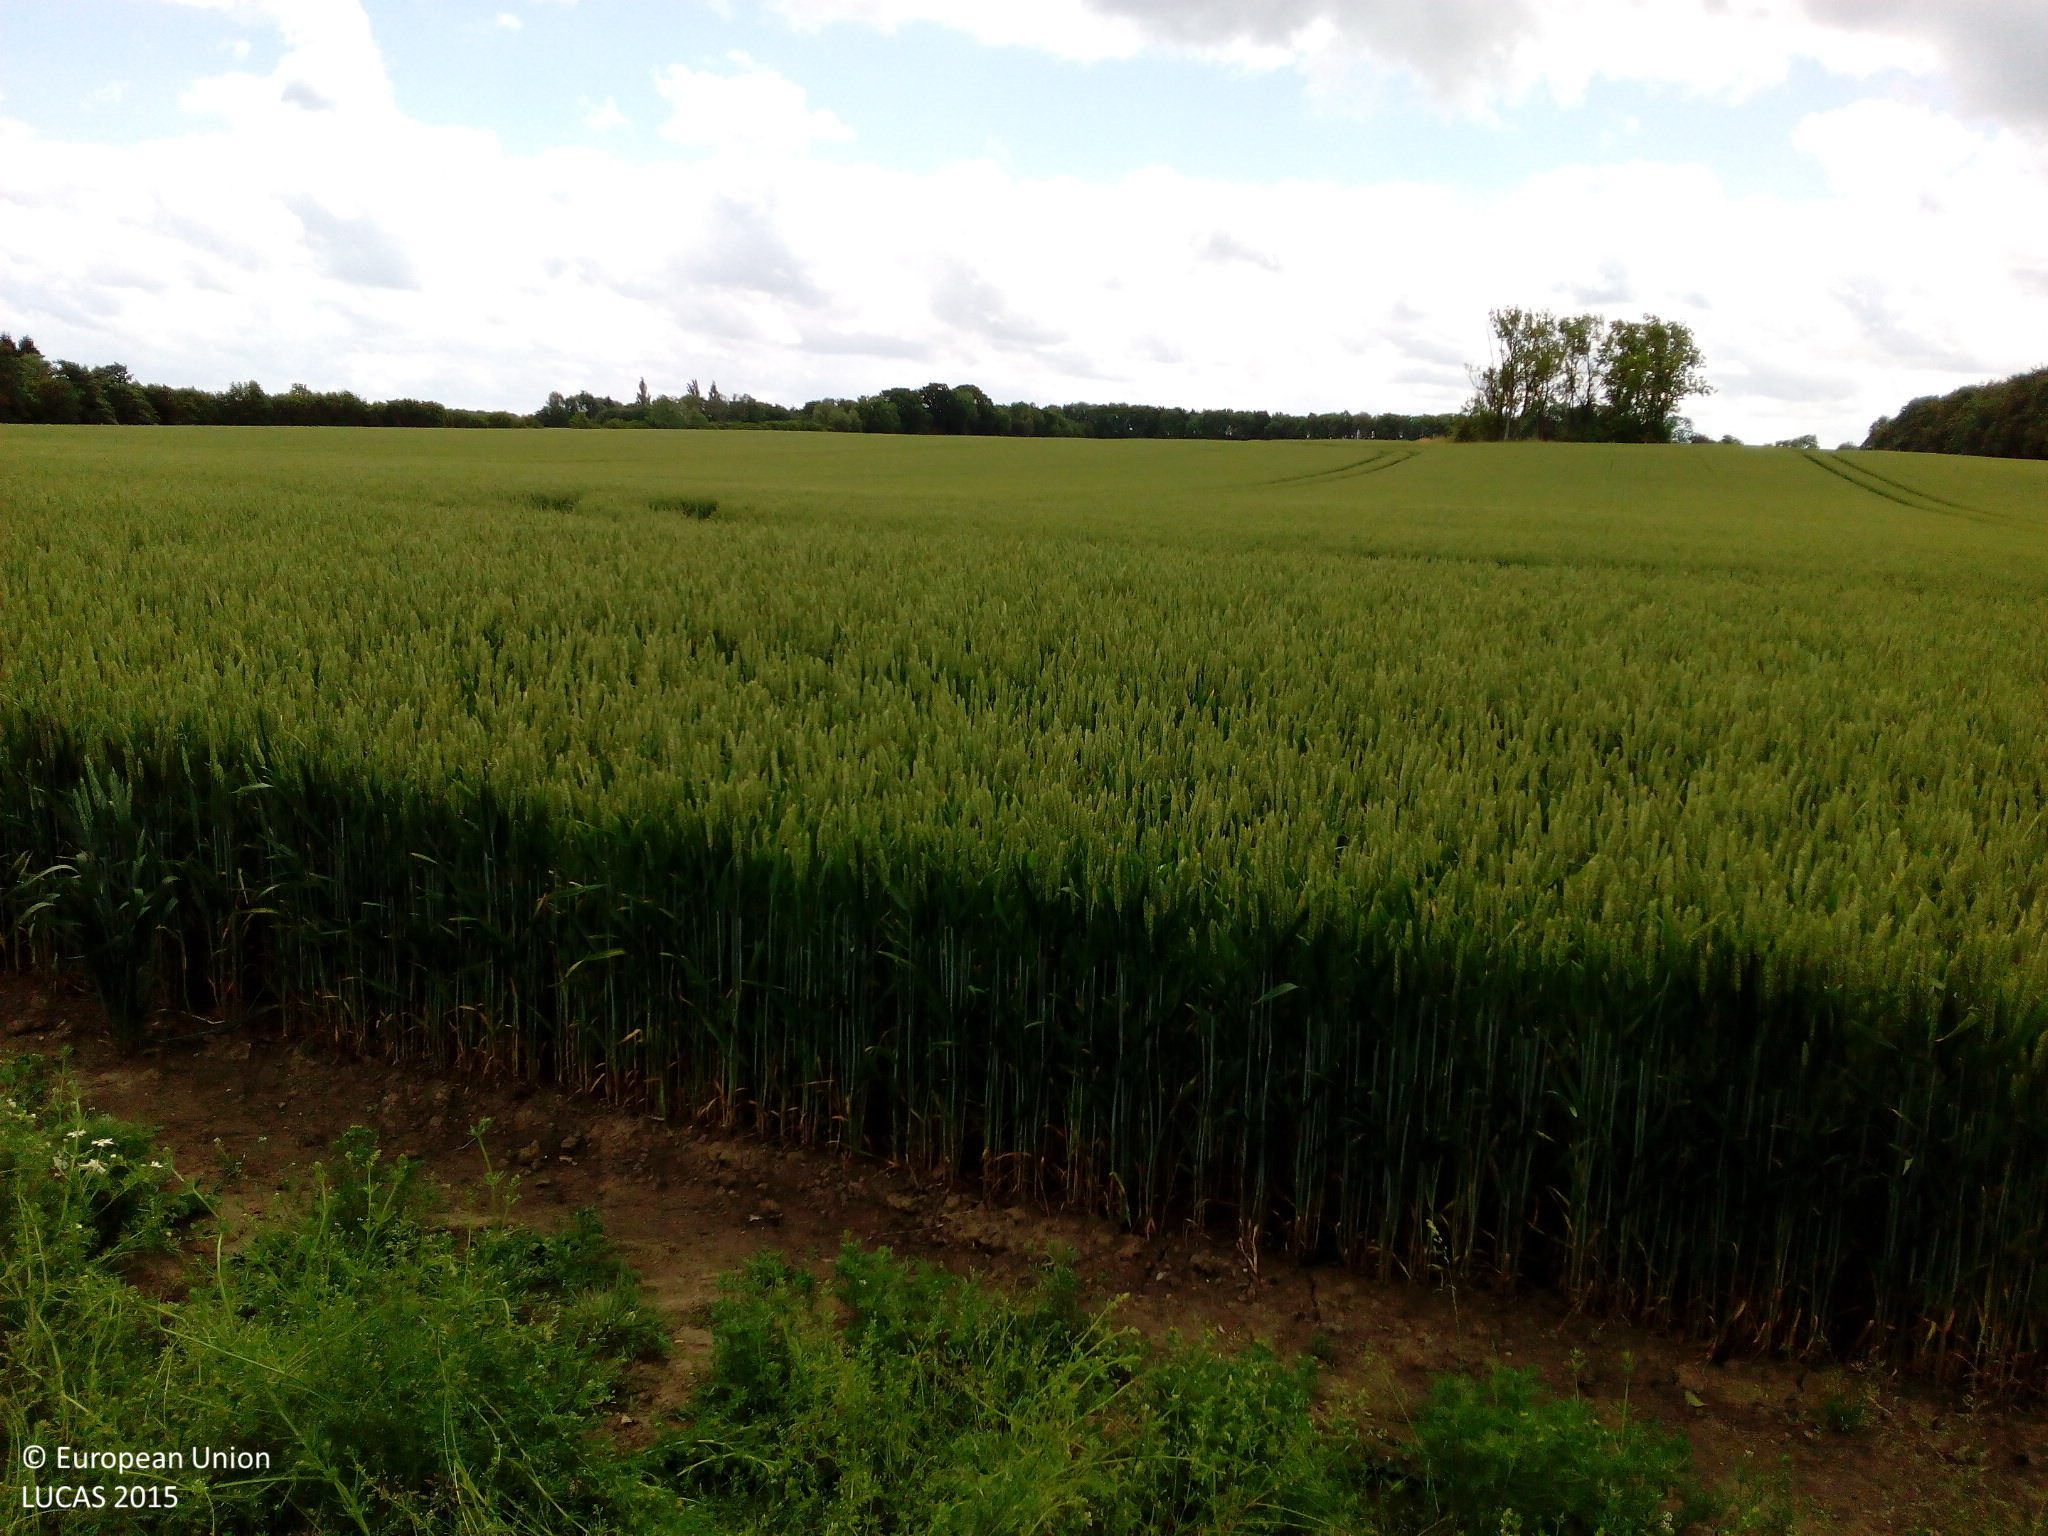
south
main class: Grassland
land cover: Spontaneously vegetated surfaces
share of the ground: > 75 %
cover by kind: herbaceous plants 100 %
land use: Agriculture (excluding fallow land and kitchen gardens)
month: July
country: DK
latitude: 55.2172
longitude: 12.1204
